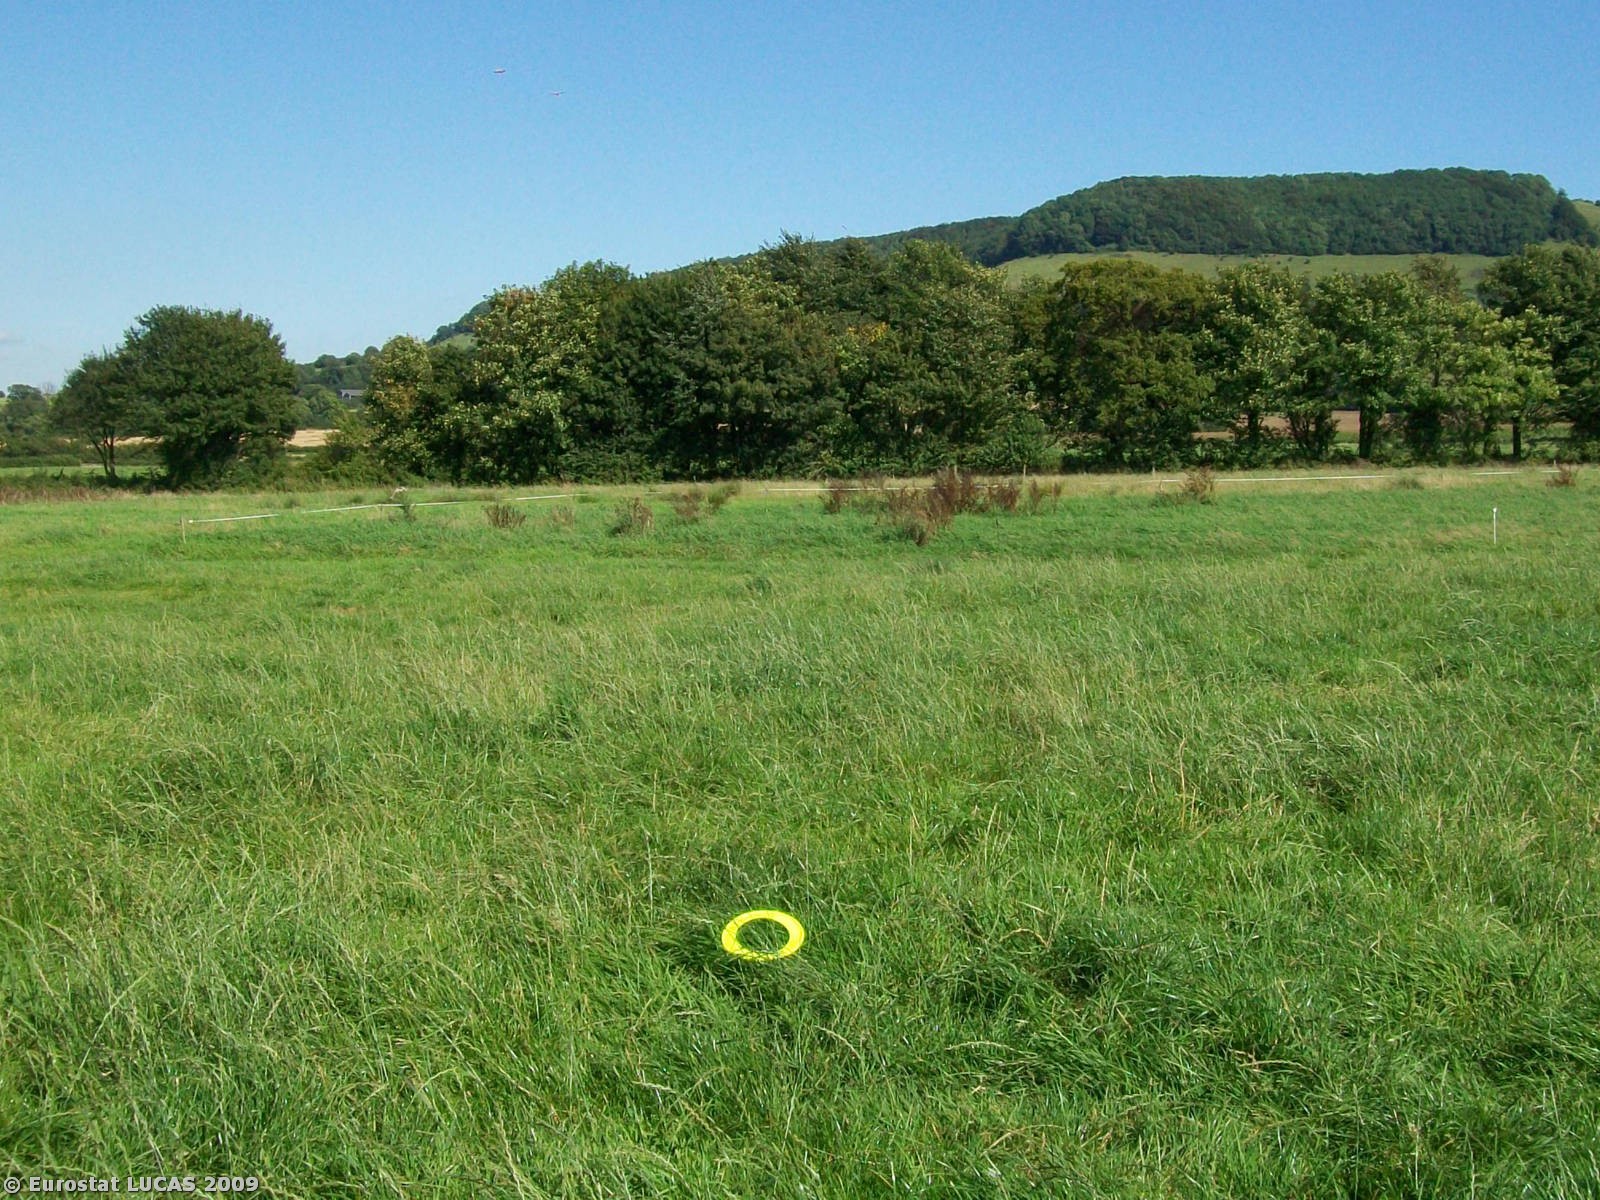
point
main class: Grassland
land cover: Grassland without tree/shrub cover
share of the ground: > 75 %
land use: Agriculture (excluding fallow land and kitchen gardens)
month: August
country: GB
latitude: 51.7142
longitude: -2.3227
